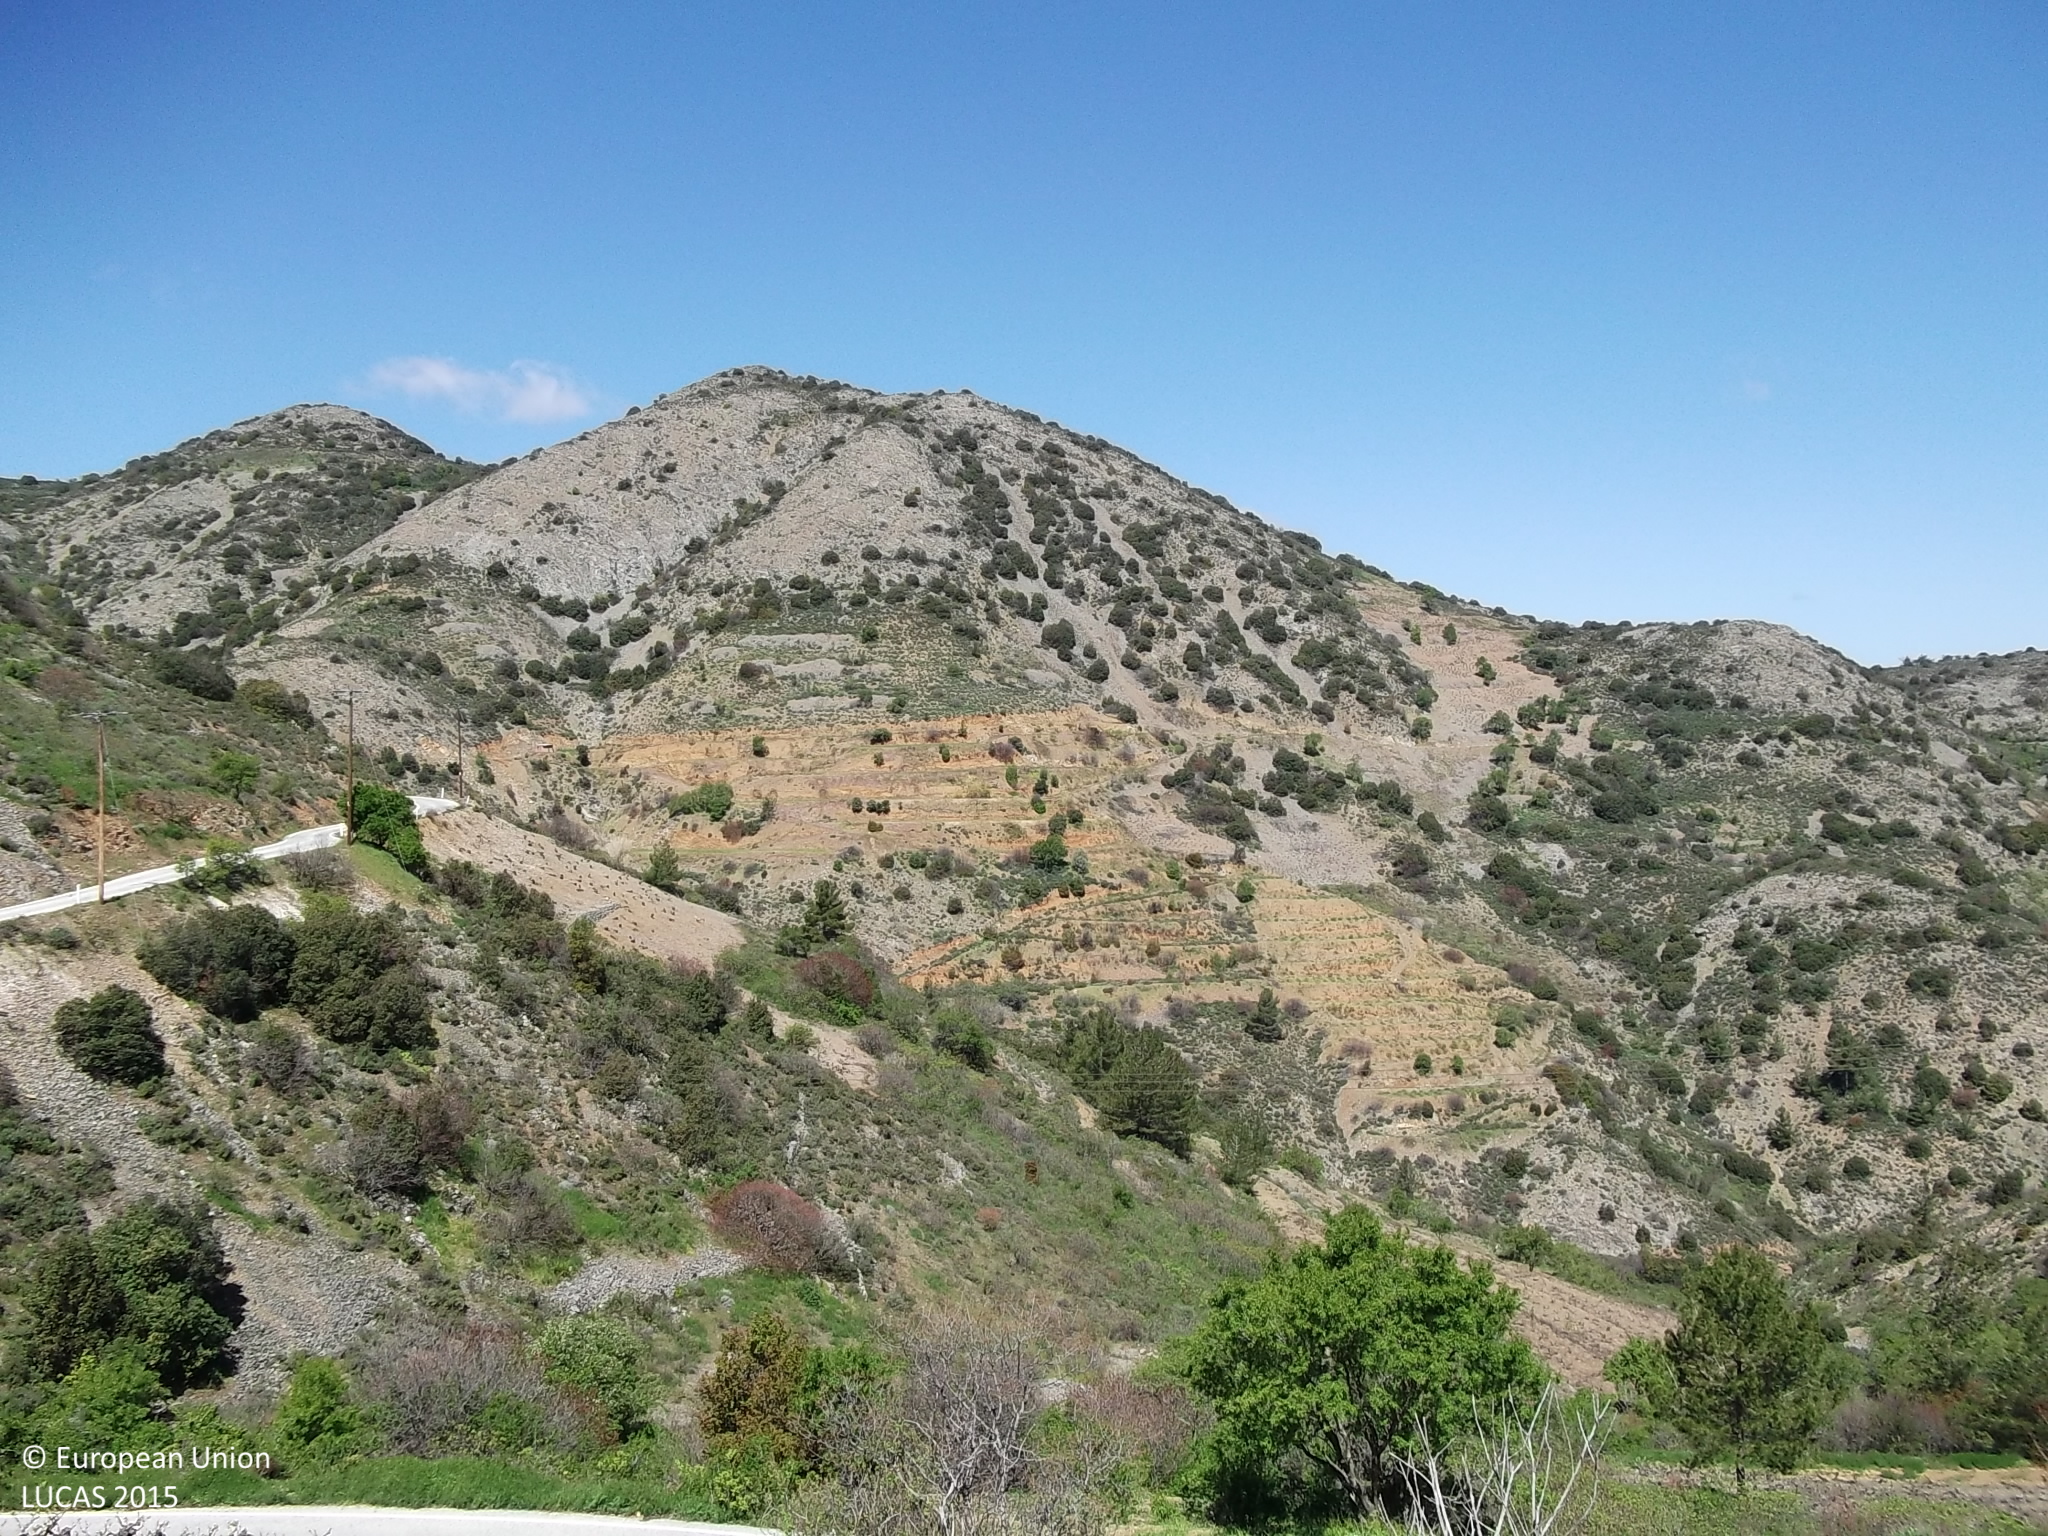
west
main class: Cropland
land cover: Vineyards
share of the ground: 10 - 25 %
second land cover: Rocks and stones
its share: > 75 %
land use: Agriculture (excluding fallow land and kitchen gardens)
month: April
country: CY
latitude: 34.8940
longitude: 33.1219
